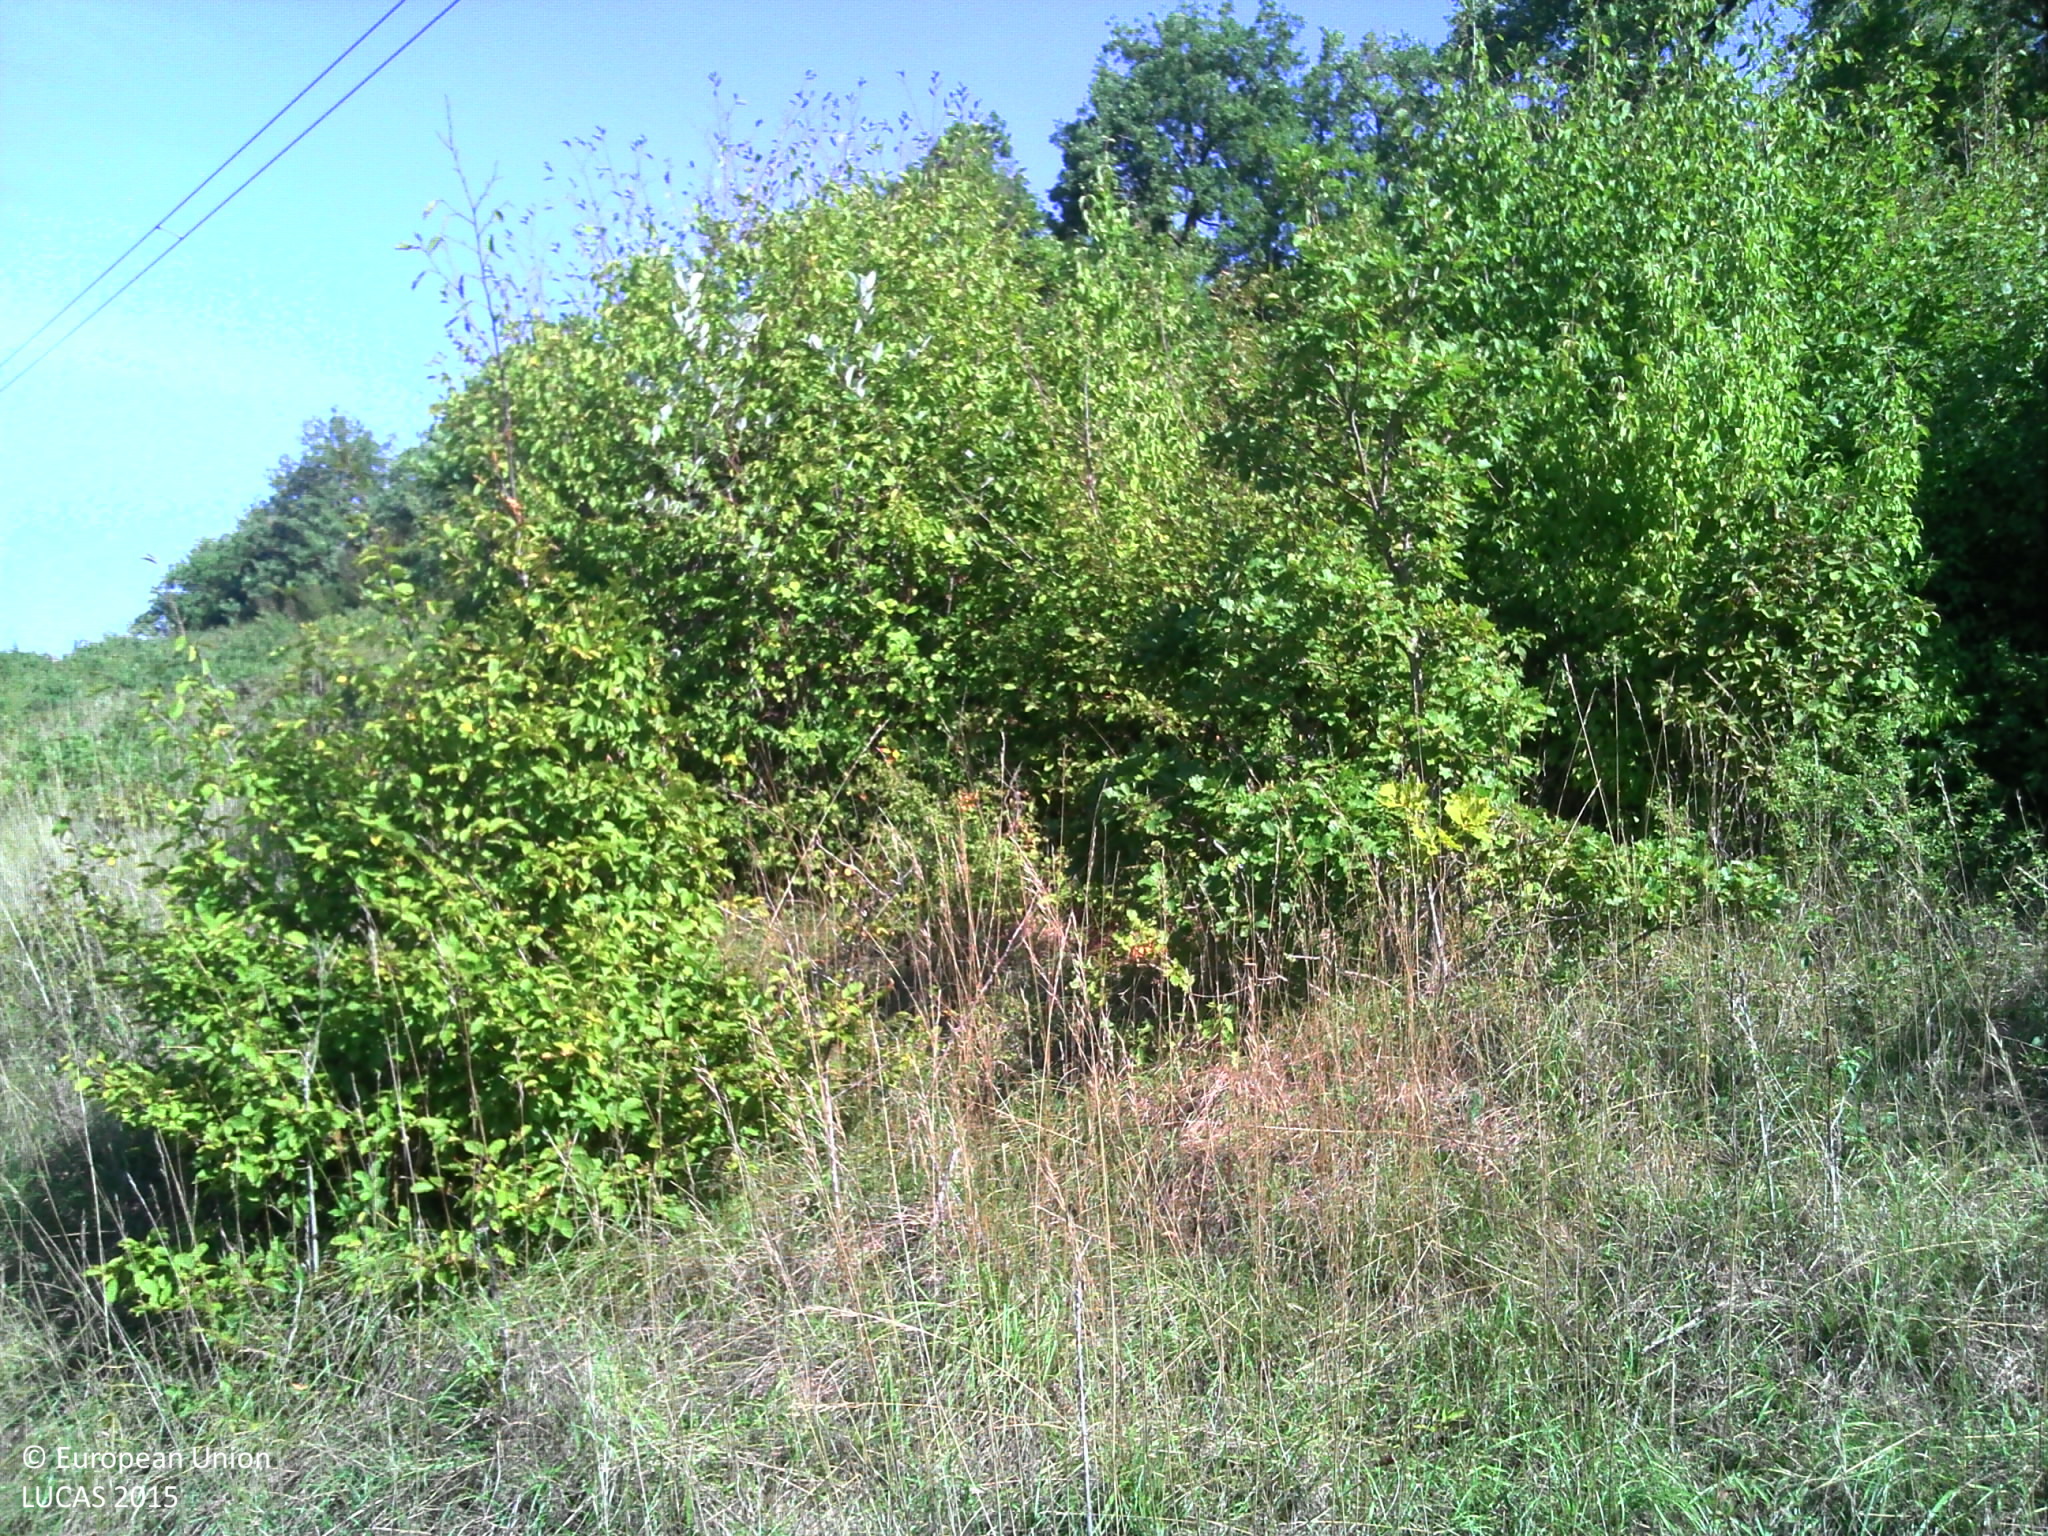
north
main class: Woodland
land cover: Broadleaved woodland
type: mesophytic deciduous forest
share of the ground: > 75 %
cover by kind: broadleaved forest trees 70 %, herbaceous plants 20 %, shrubs 10 %
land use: Semi-natural and natural areas not in use
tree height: < 5 m
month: August
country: FR
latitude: 47.2369
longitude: 4.8354
